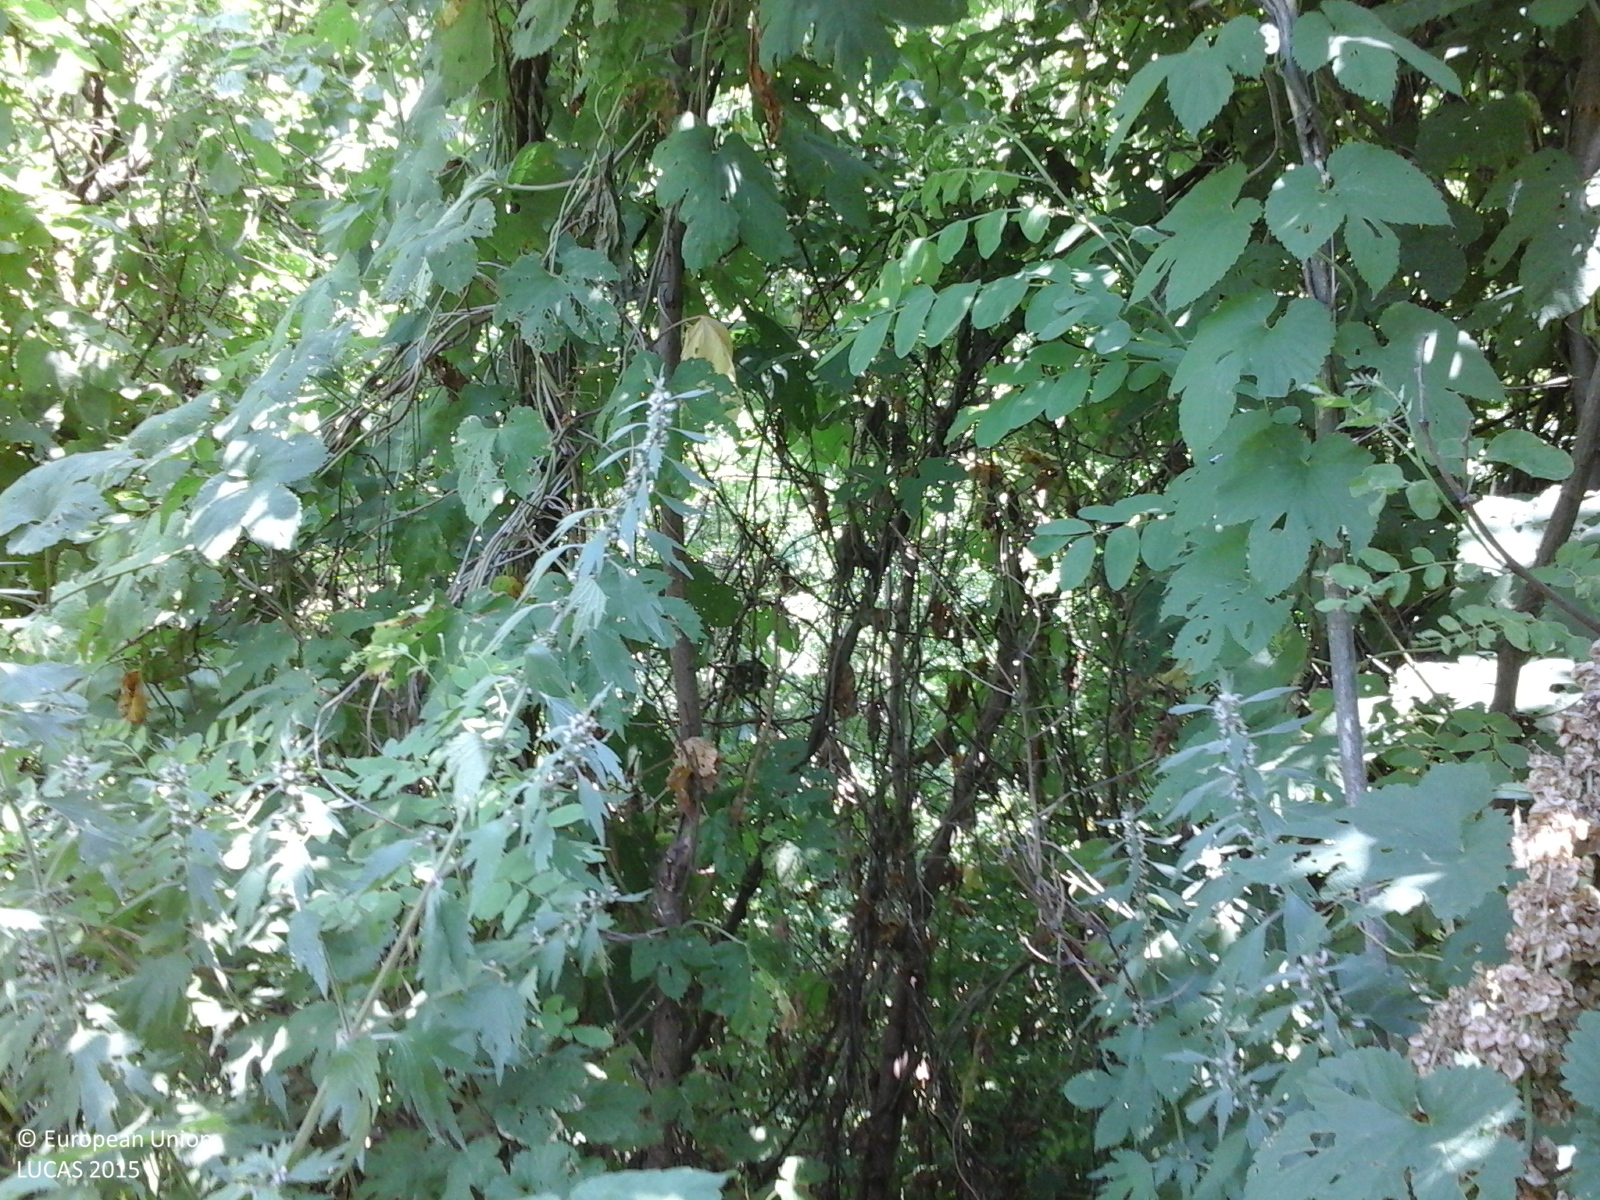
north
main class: Woodland
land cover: Broadleaved woodland
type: beech forest
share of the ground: > 75 %
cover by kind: broadleaved forest trees 100 %
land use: Forestry
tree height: > 5 m
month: June
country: RO
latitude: 46.8141
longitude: 28.0191
